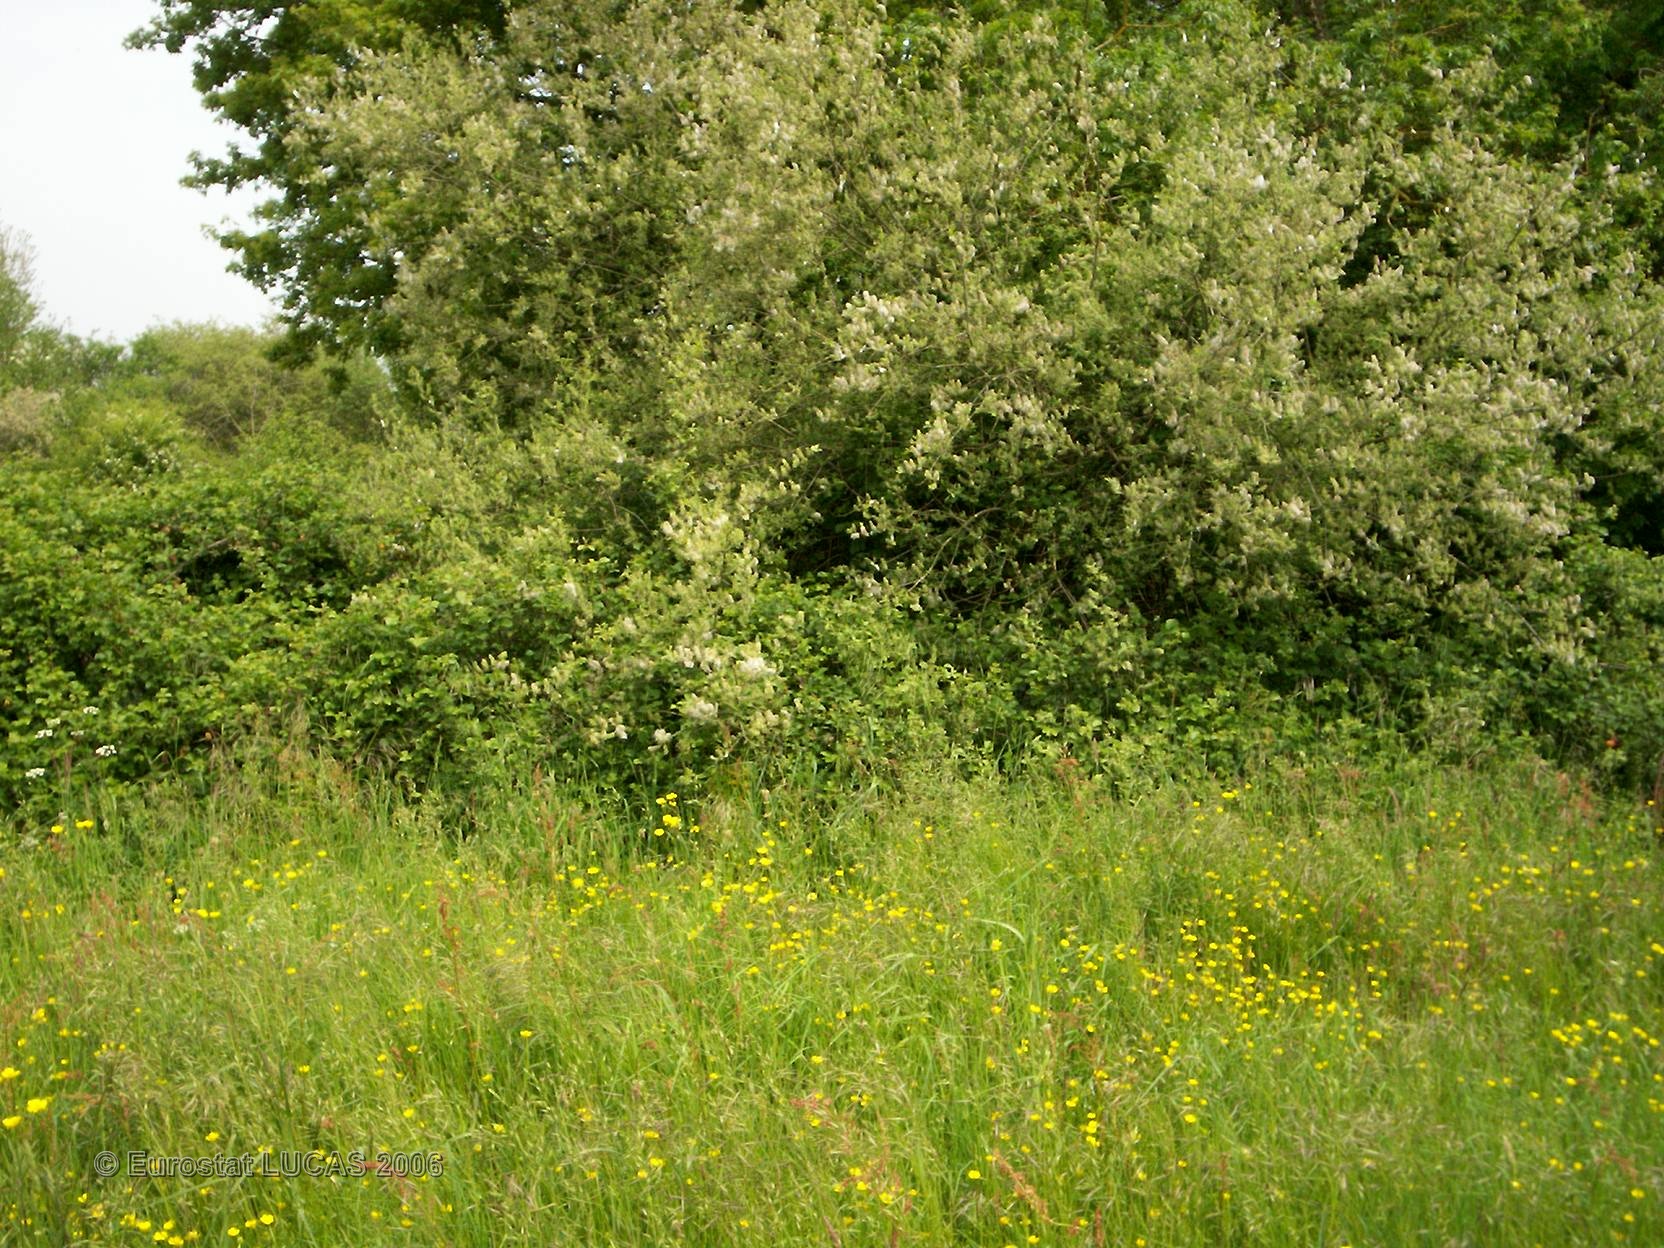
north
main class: Grassland
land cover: Grassland without tree/shrub cover
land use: Agriculture (excluding fallow land and kitchen gardens)
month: May
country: FR
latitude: 47.7083
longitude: -1.5193
